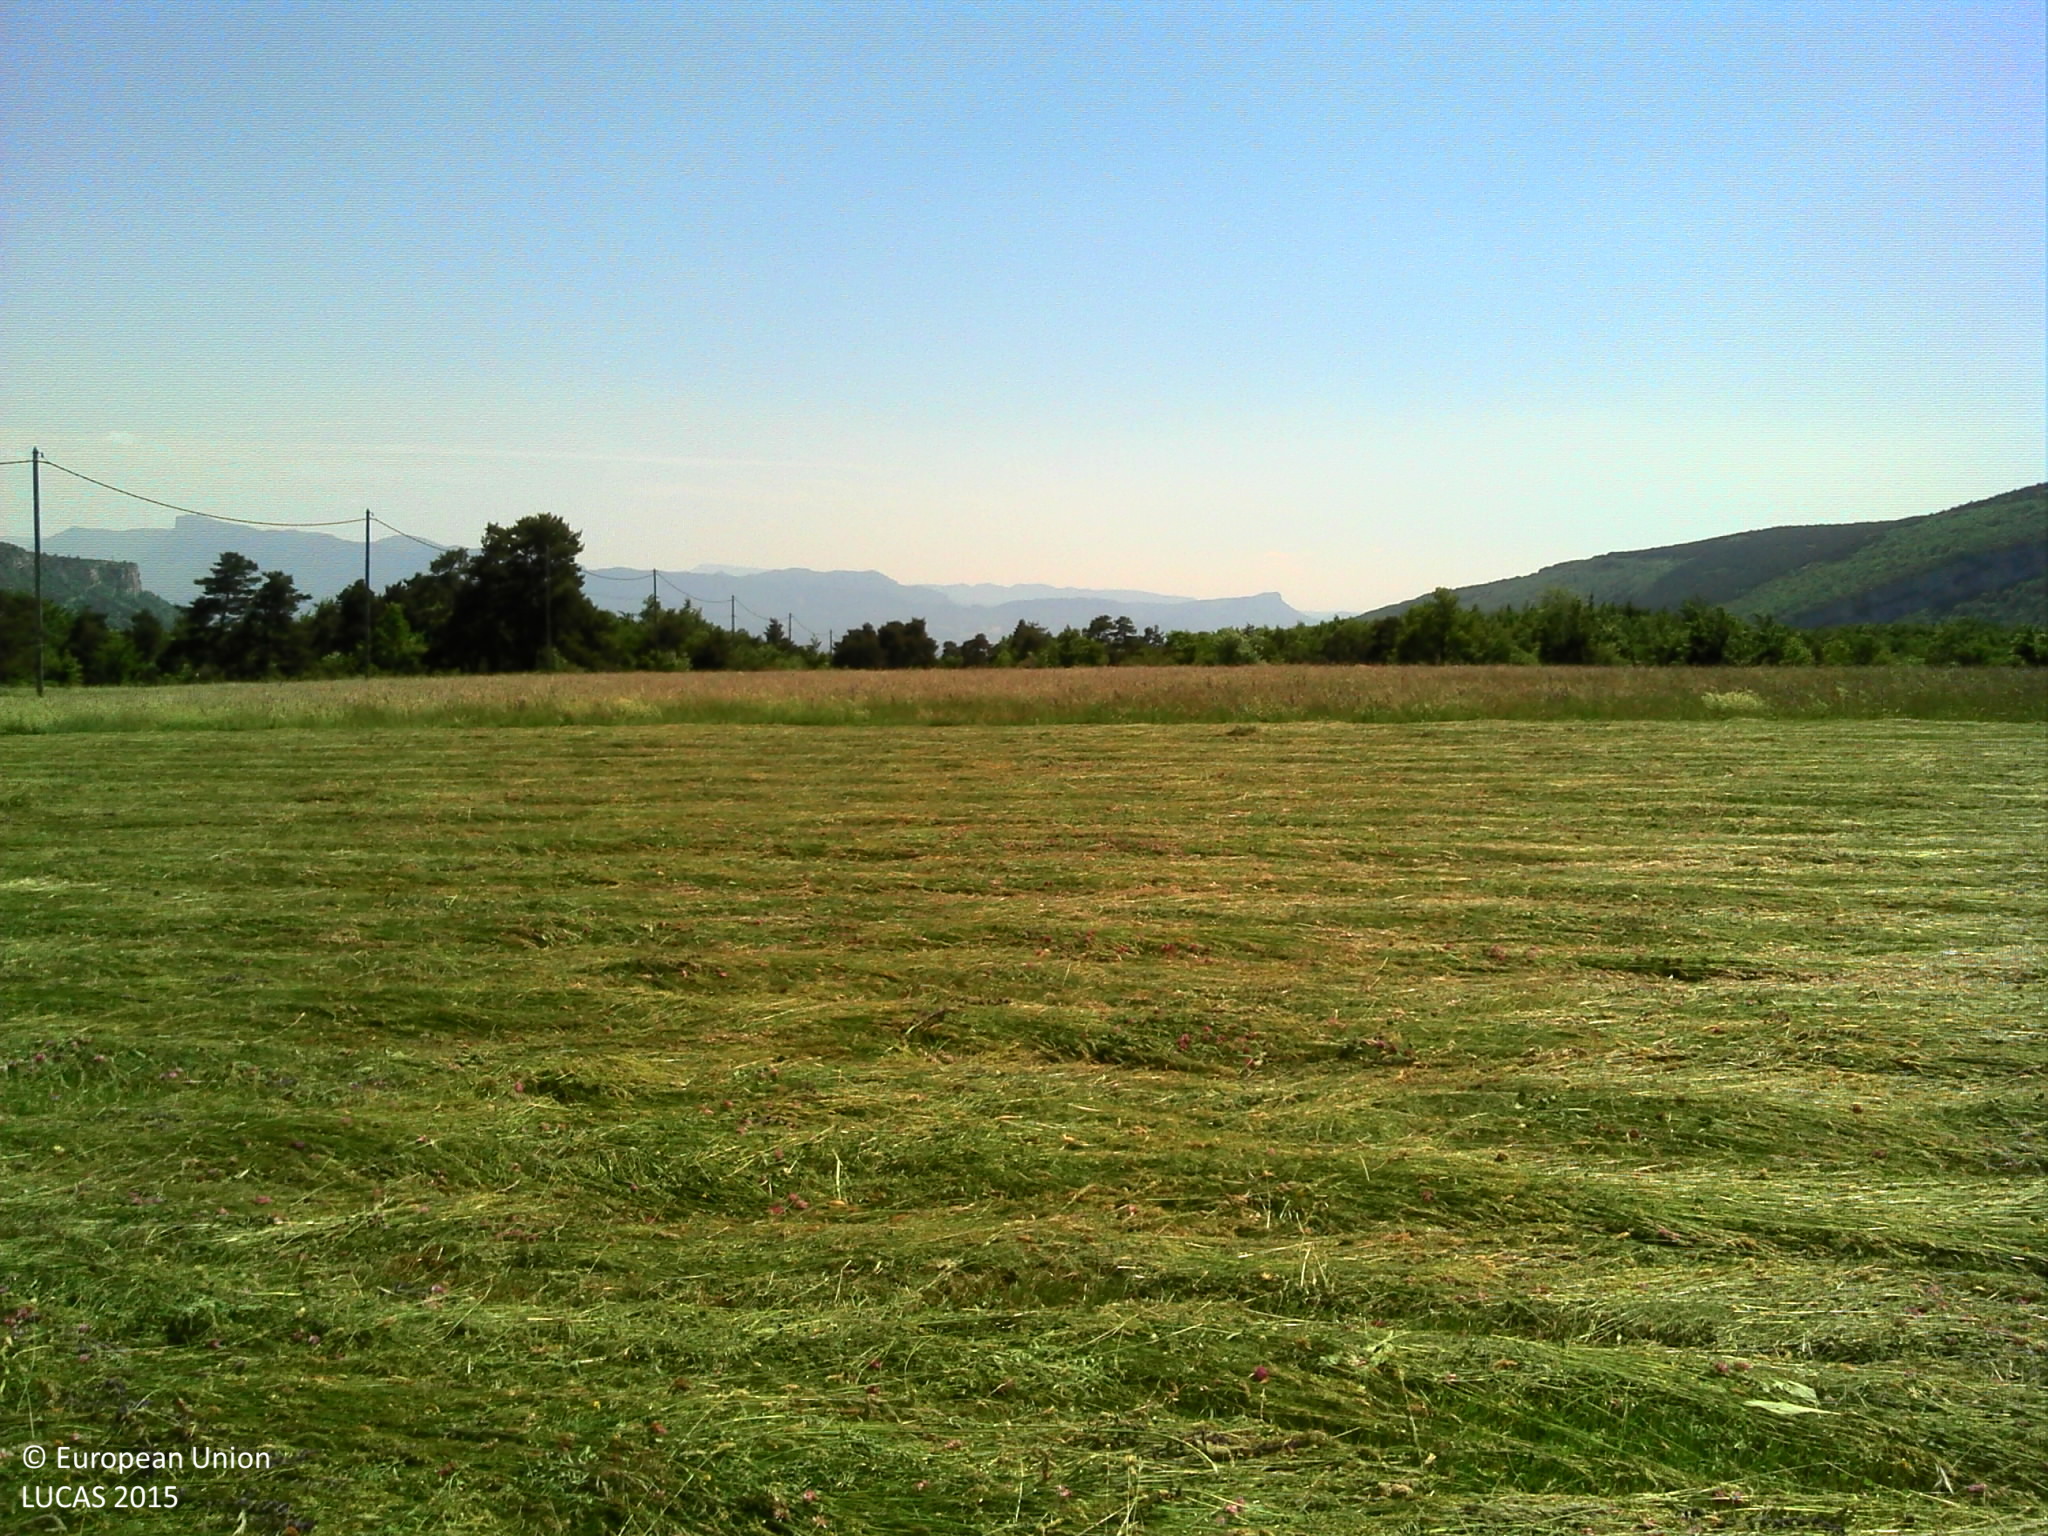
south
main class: Grassland
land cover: Grassland without tree/shrub cover
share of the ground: > 75 %
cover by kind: herbaceous plants 100 %
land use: Agriculture (excluding fallow land and kitchen gardens)
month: June
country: FR
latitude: 44.8518
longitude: 5.1599
